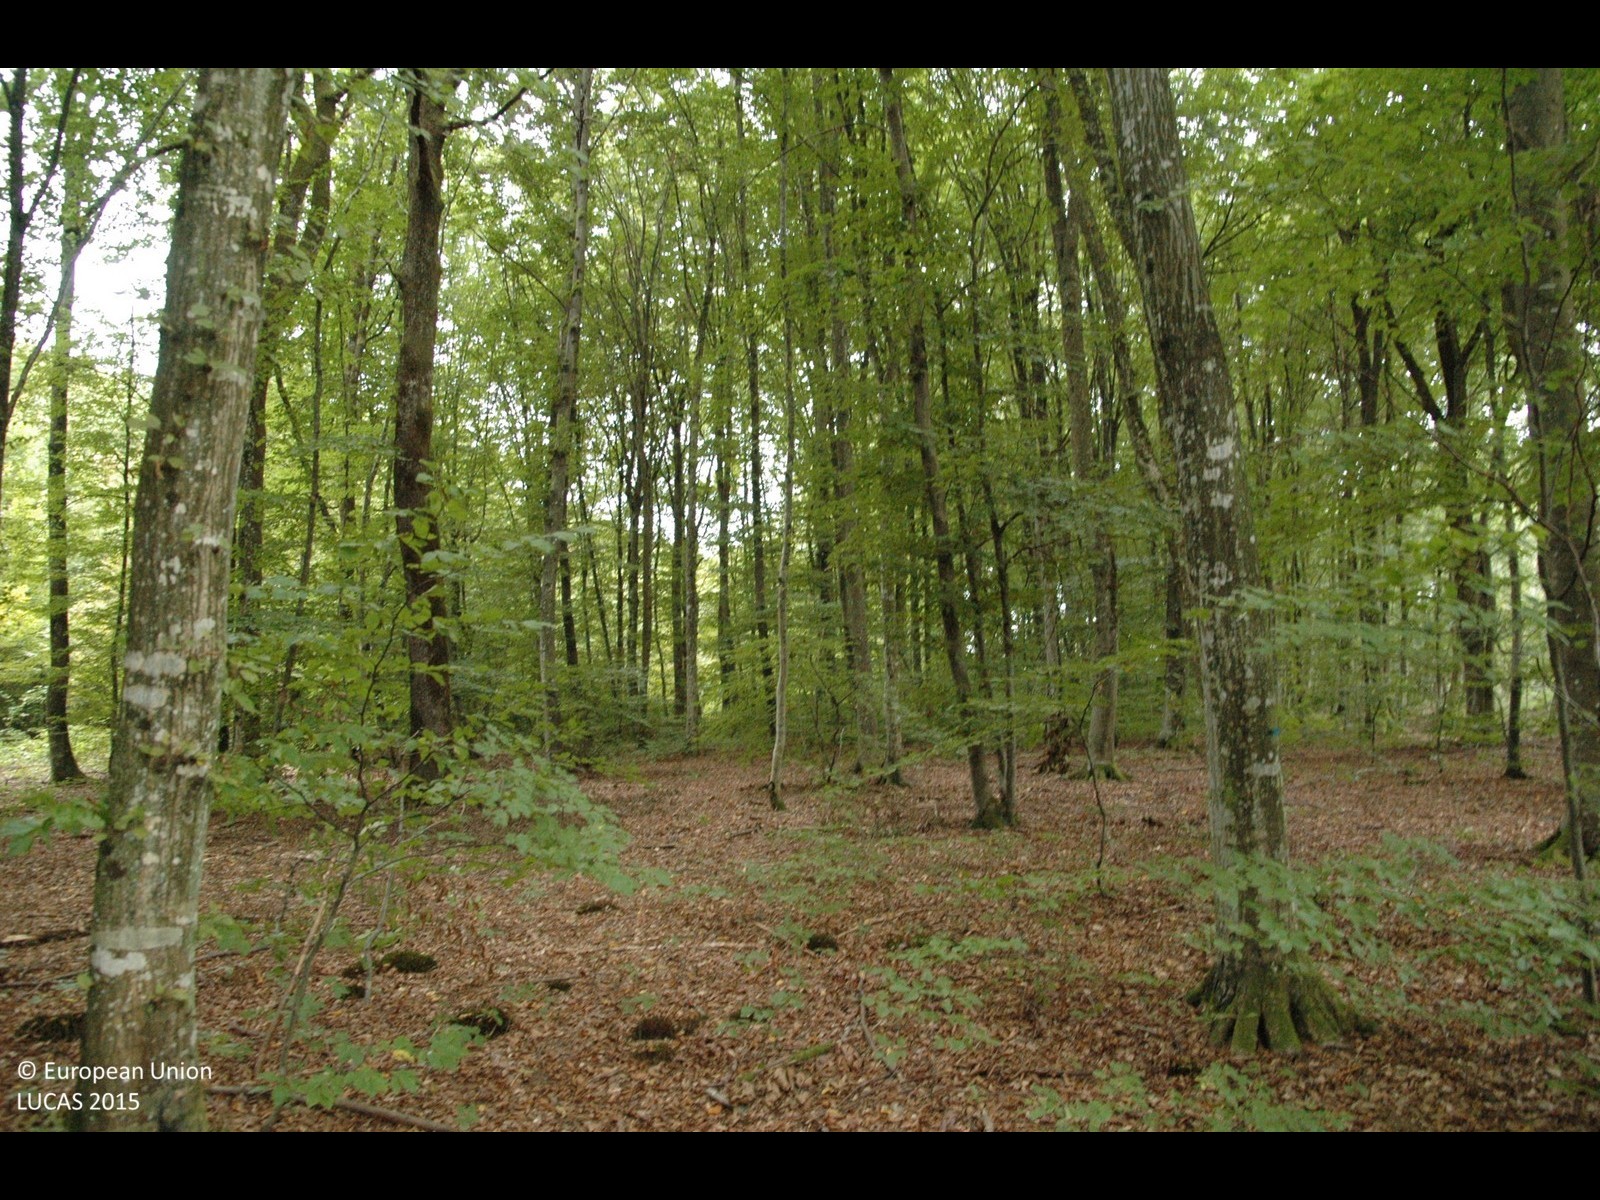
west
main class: Woodland
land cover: Broadleaved woodland
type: beech forest
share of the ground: > 75 %
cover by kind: broadleaved forest trees 100 %
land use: Forestry
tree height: > 5 m
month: October
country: HR
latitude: 45.5609
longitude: 16.1342
